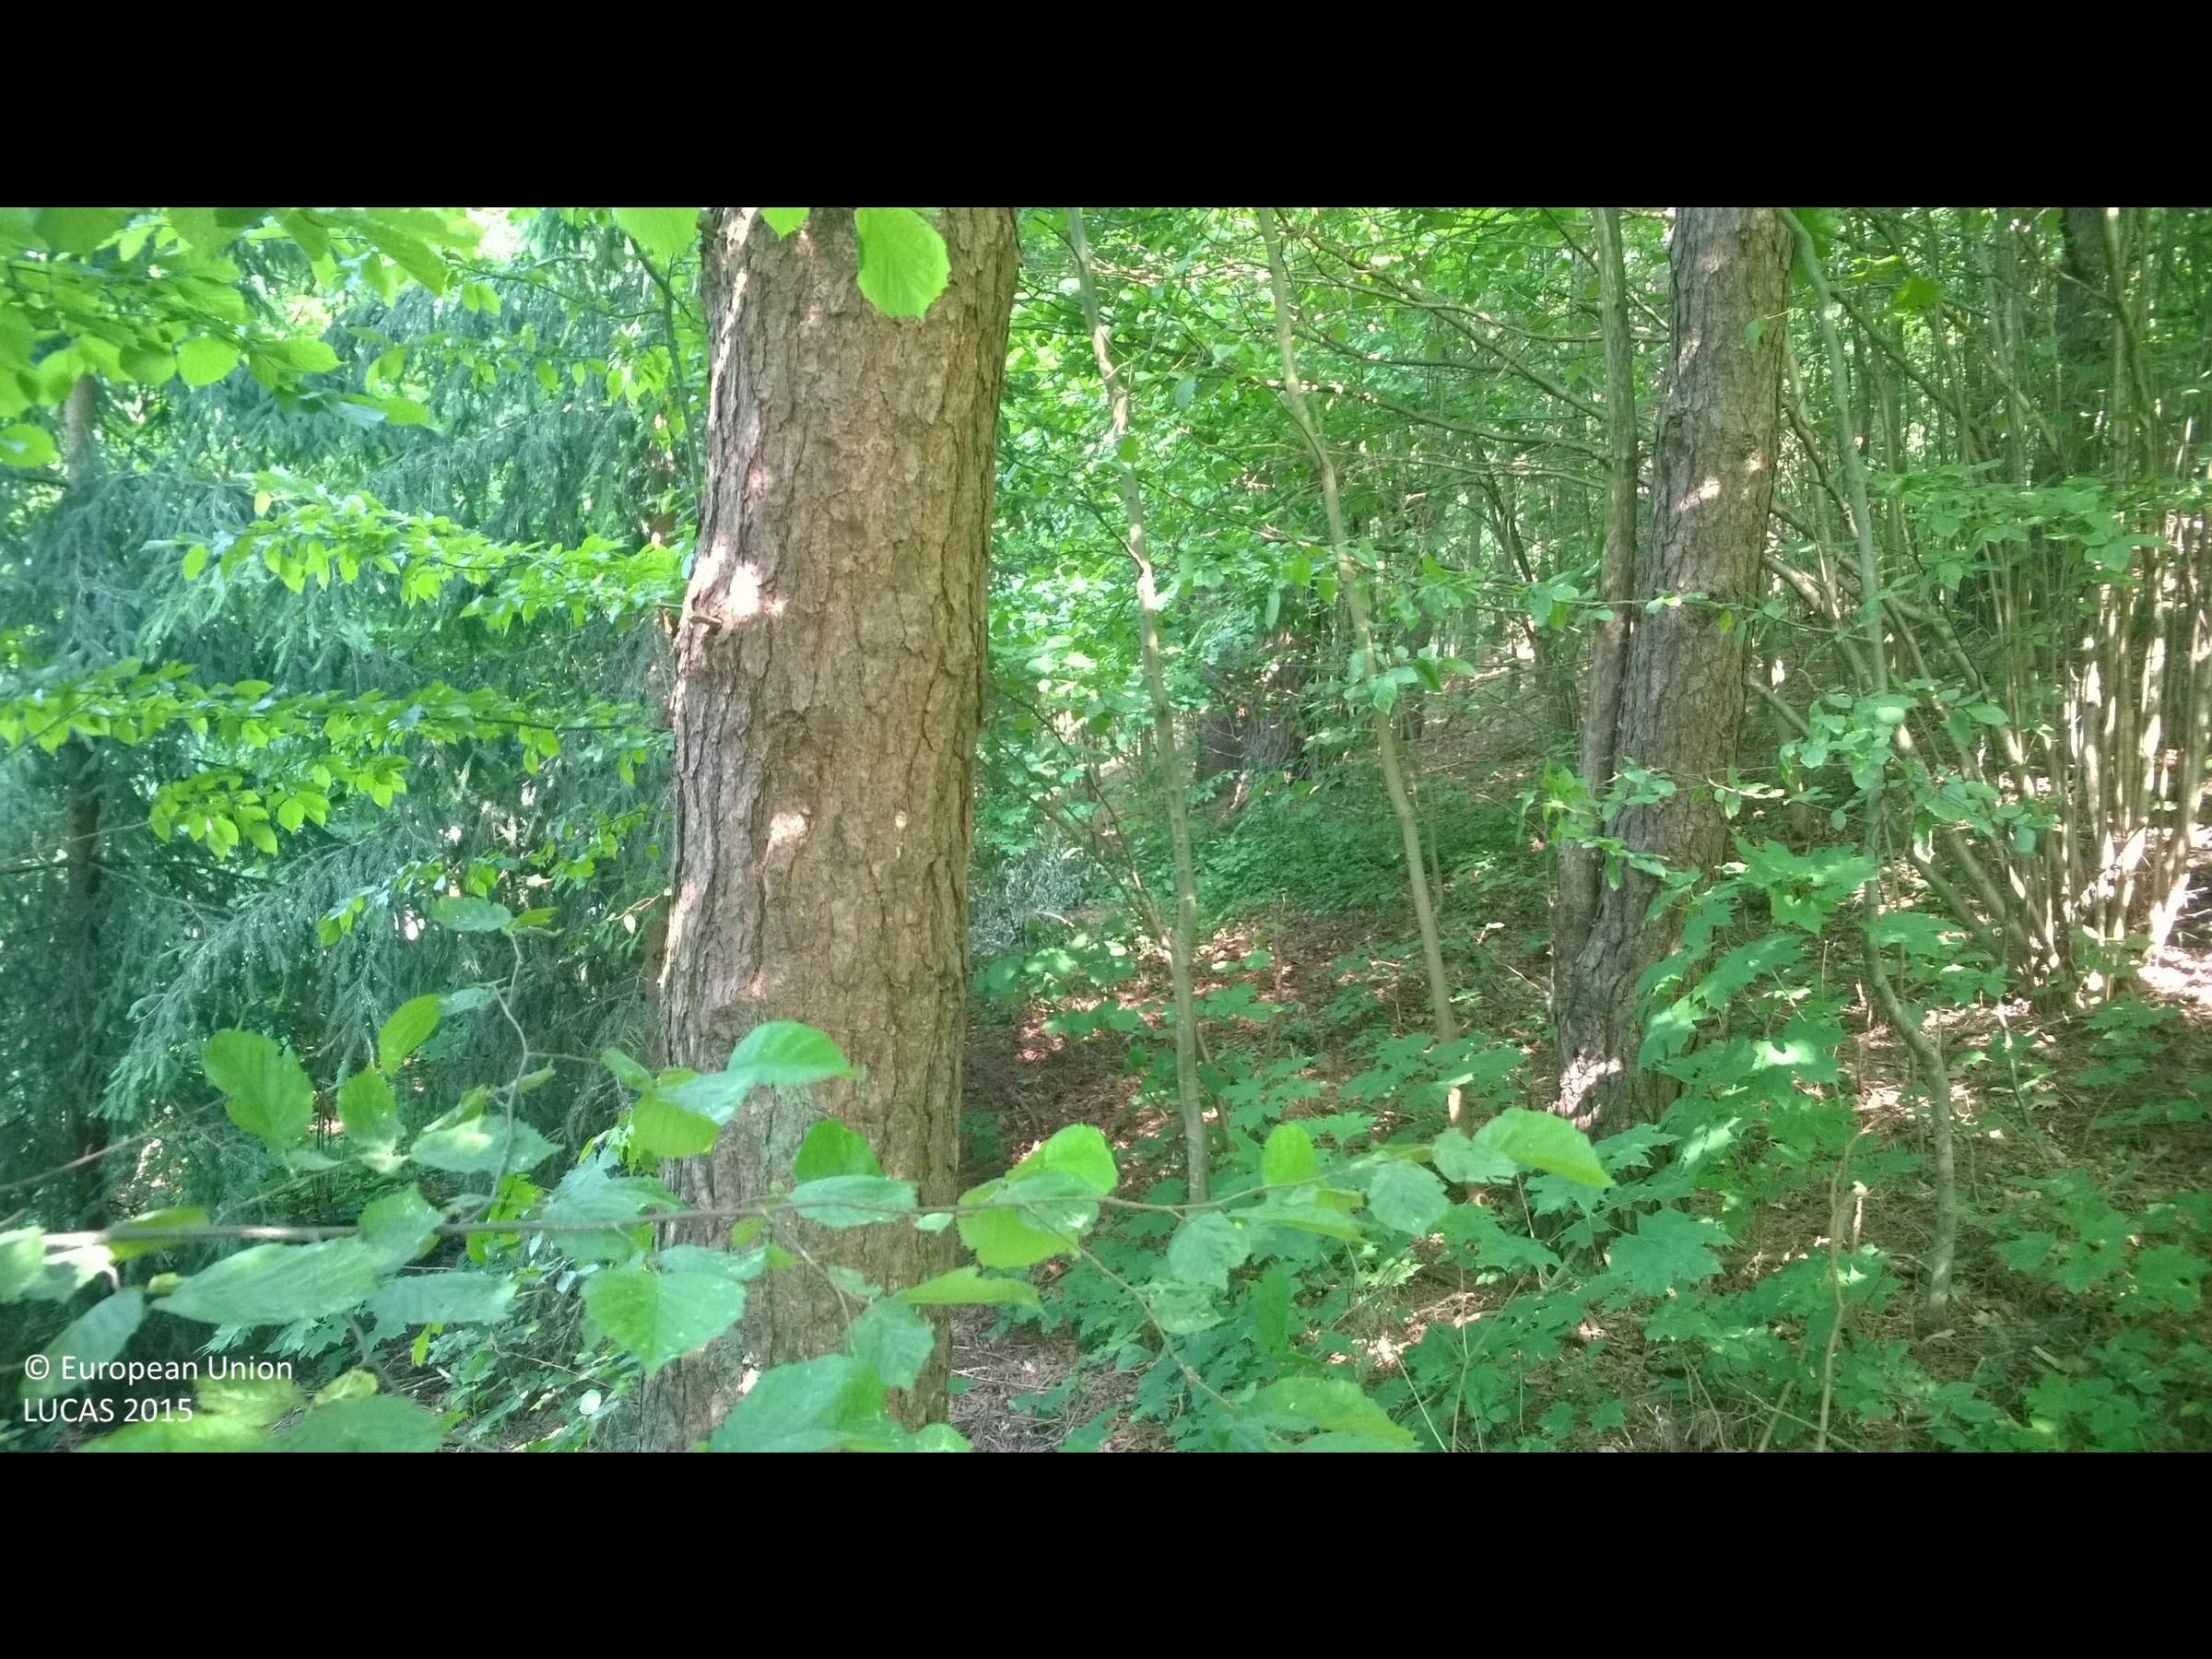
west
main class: Woodland
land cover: Pine dominated mixed woodland
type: hemiboreal forest and nemoral coniferous forest and mixed broadleaved-coniferous forest
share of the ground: > 75 %
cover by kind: coniferous forest trees 50 %, broadleaved forest trees 35 %, shrubs 10 %, herbaceous plants 5 %
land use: Forestry
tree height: > 5 m
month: June
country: PL
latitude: 53.1096
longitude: 23.3921
